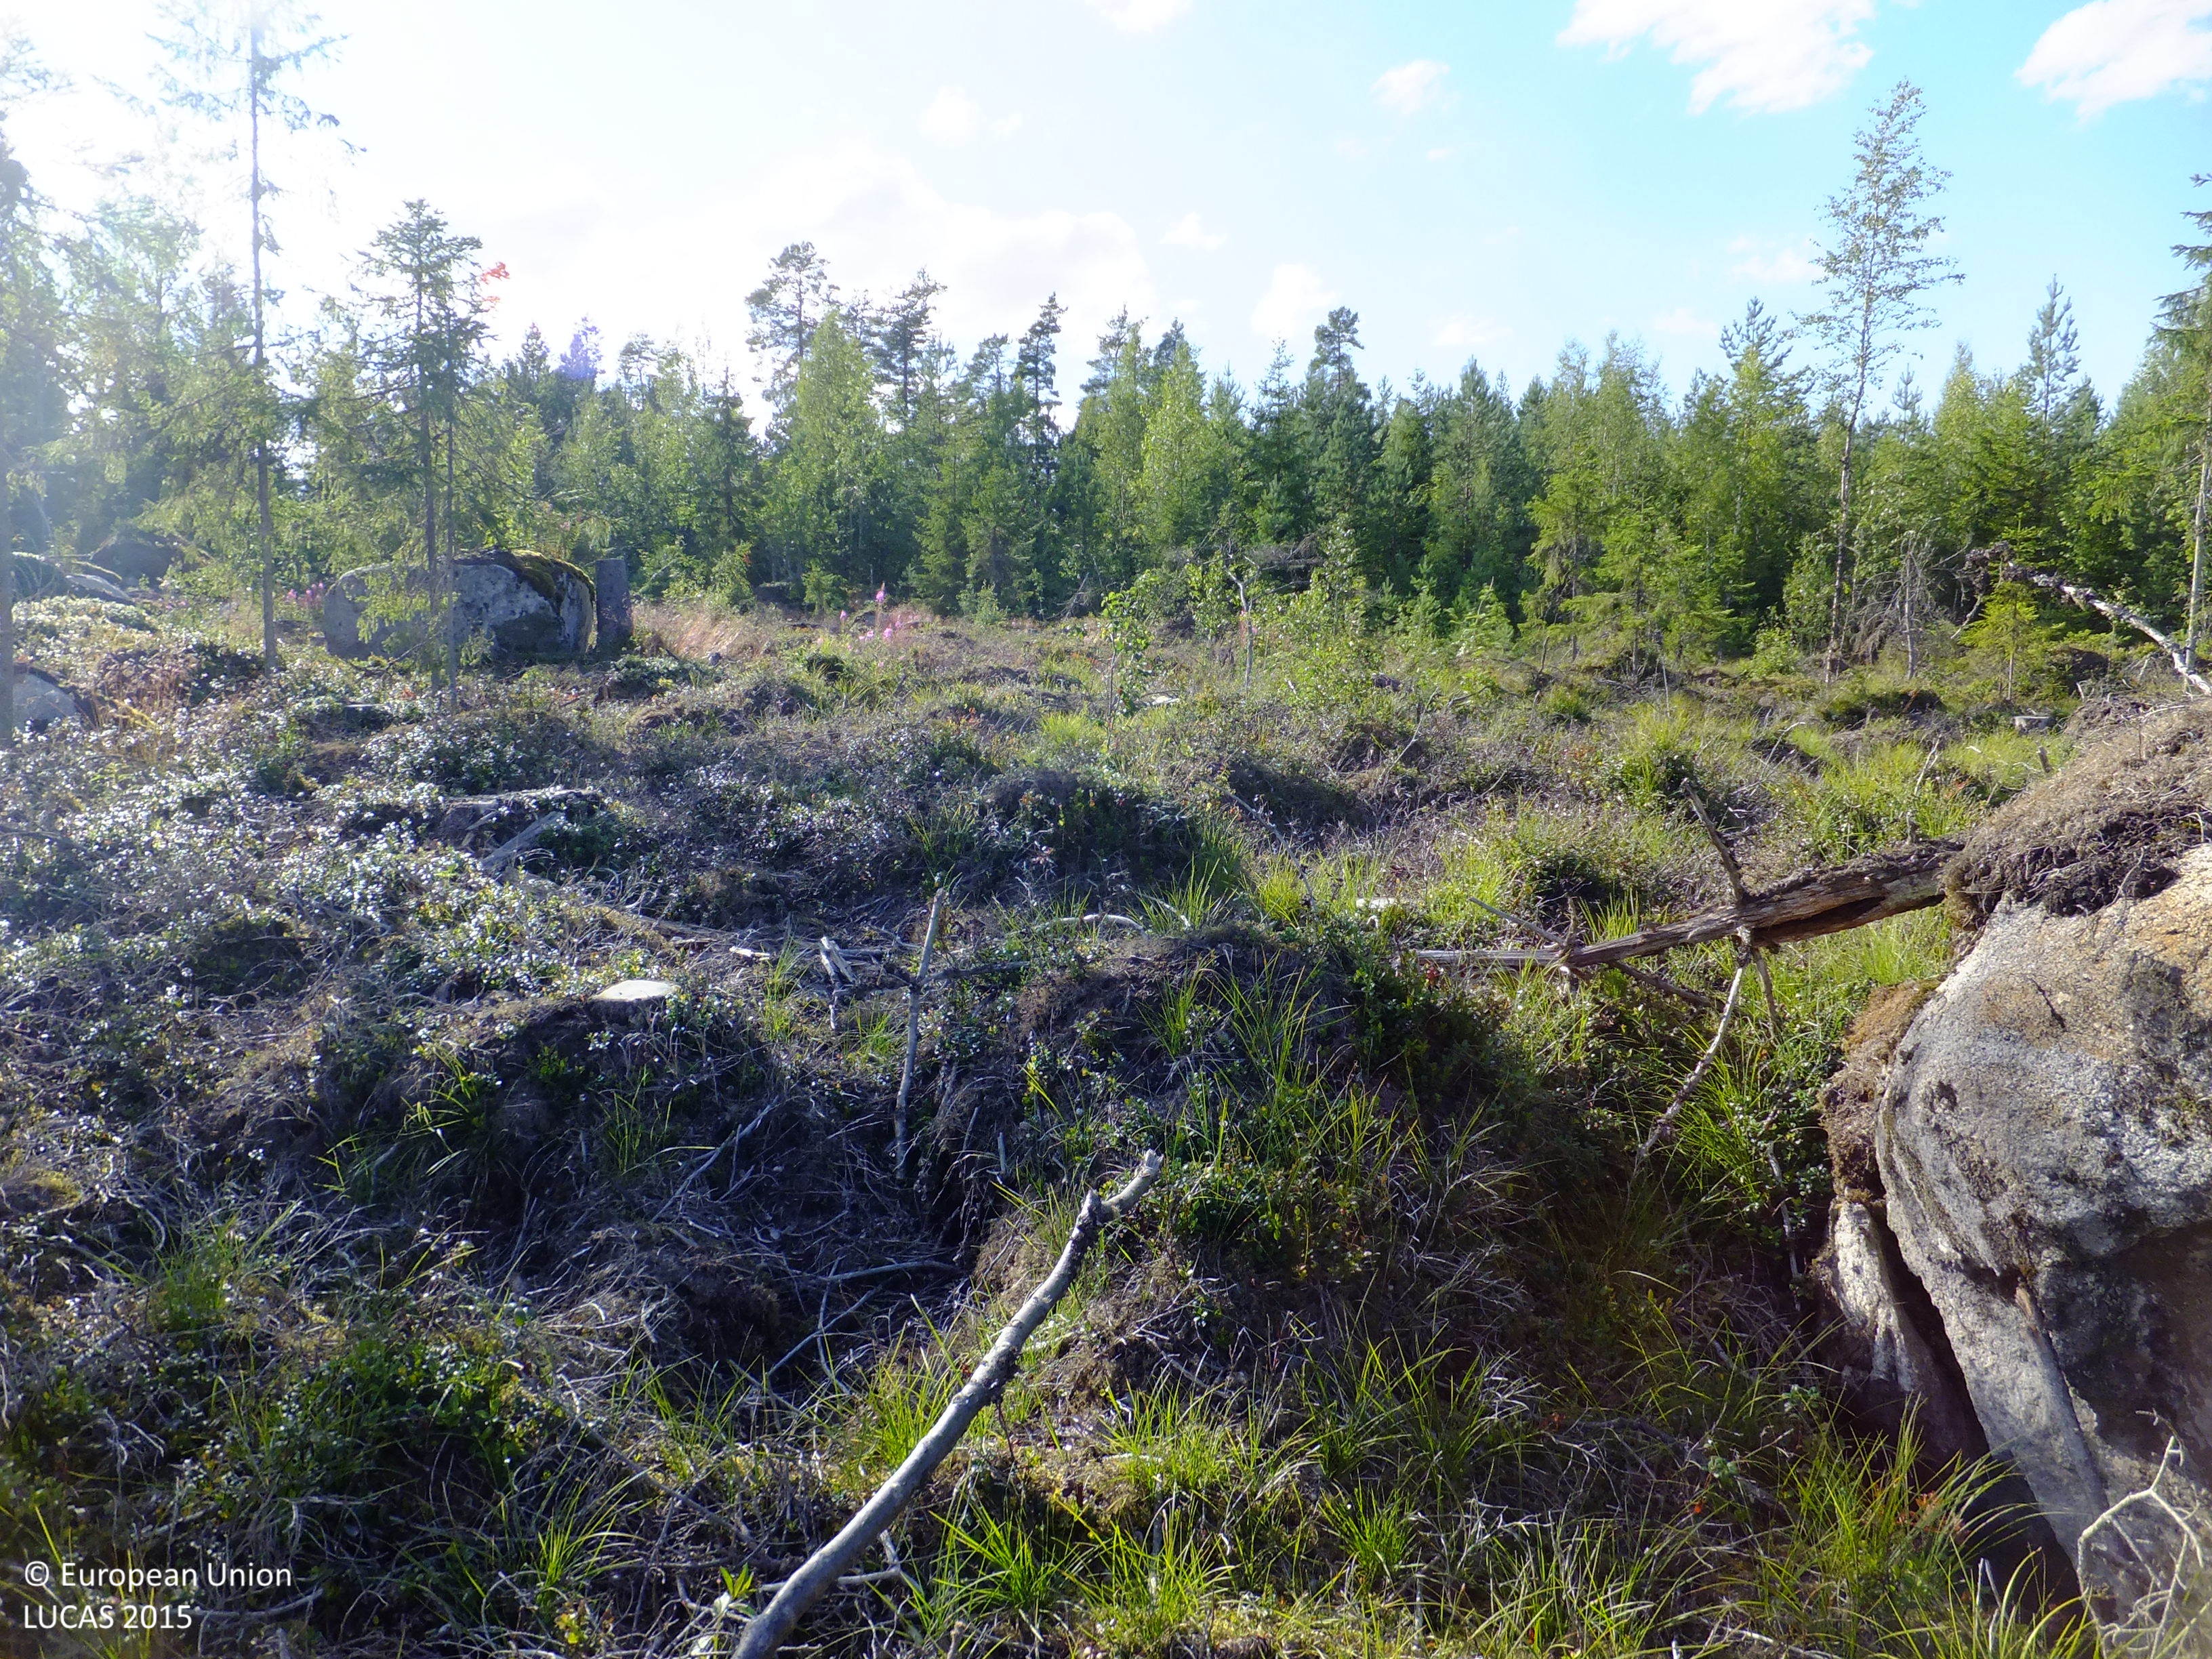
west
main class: Shrubland
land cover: Shrubland with sparse tree cover
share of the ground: > 75 %
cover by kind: herbaceous plants 40 %, unconsolidated bare surface 25 %, consolidated bare surface 20 %, shrubs 10 %, coniferous forest trees 5 %
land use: Forestry
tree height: < 5 m
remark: Clear cut
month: August
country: FI
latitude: 63.1351
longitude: 22.6881
